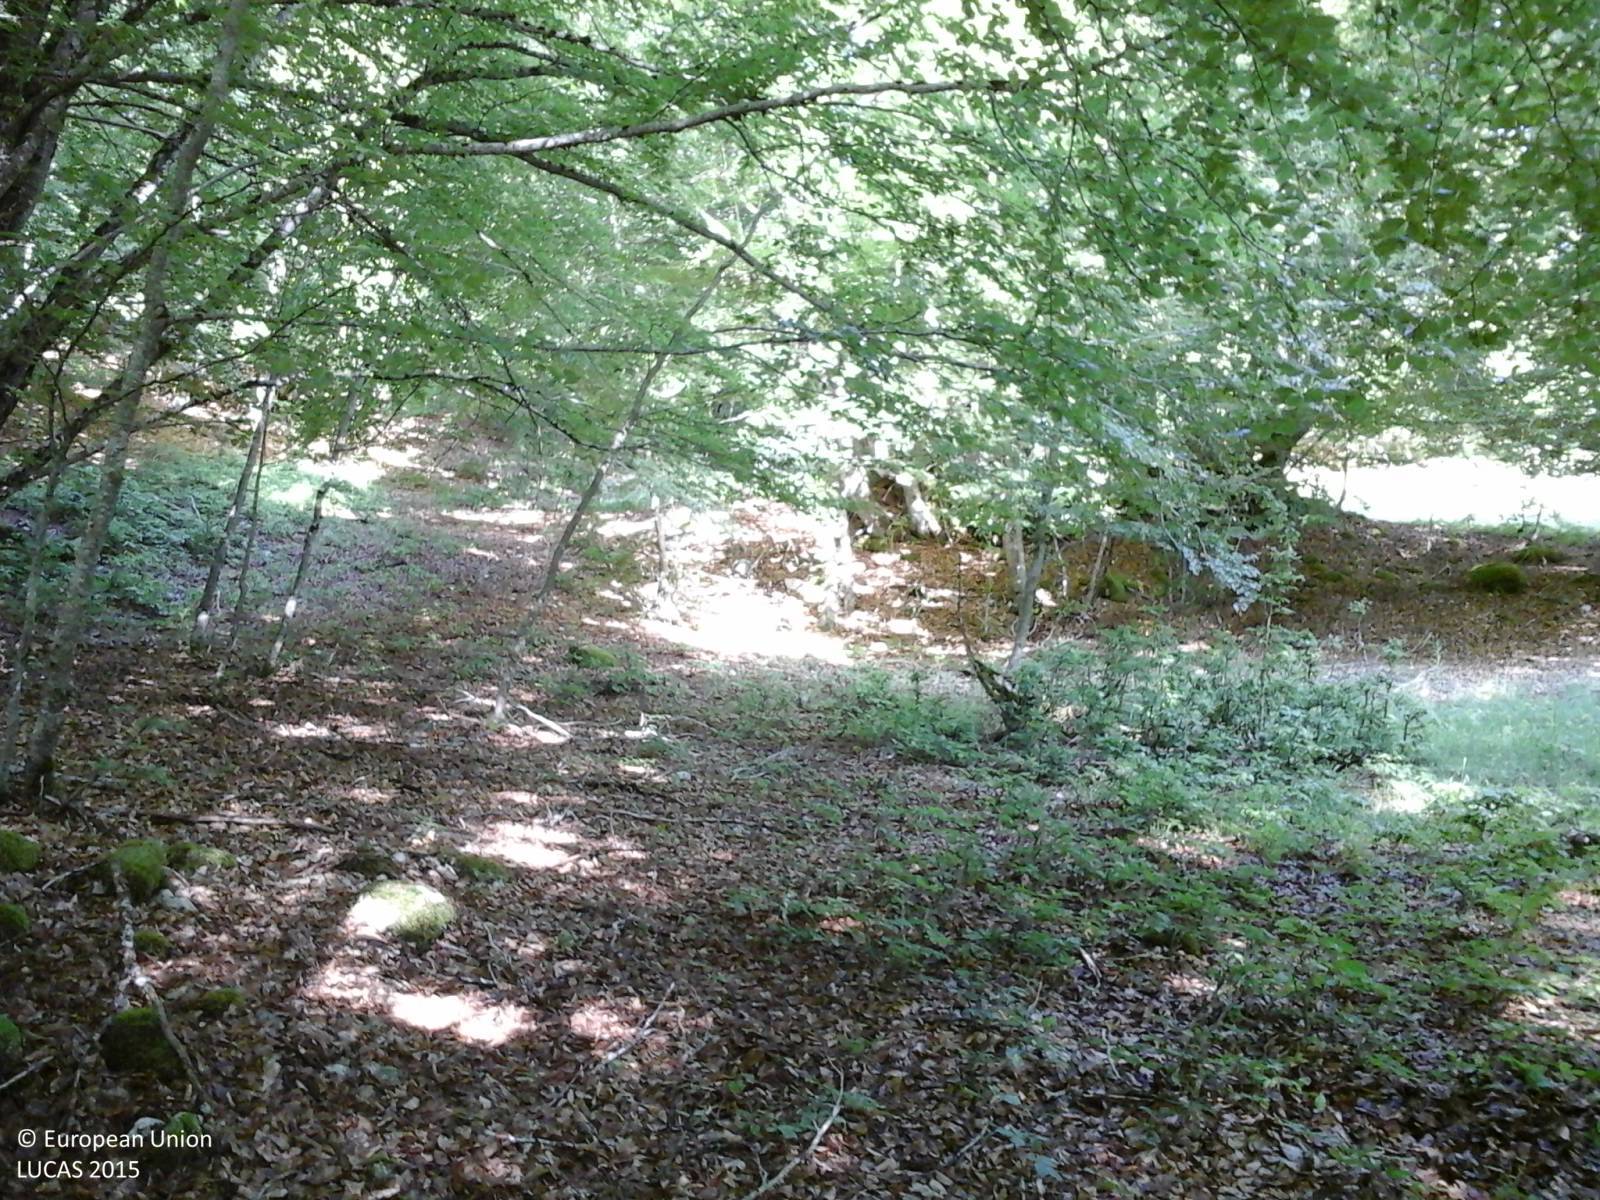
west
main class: Woodland
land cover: Broadleaved woodland
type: mountainous beech forest
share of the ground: > 75 %
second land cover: Grassland without tree/shrub cover
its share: 10 - 25 %
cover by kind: broadleaved forest trees 60 %, unconsolidated bare surface 25 %, herbaceous plants 15 %
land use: Forestry
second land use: Agriculture (excluding fallow land and kitchen gardens)
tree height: > 5 m
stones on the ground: < 10 %
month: May
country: IT
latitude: 41.7879
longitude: 13.7769
